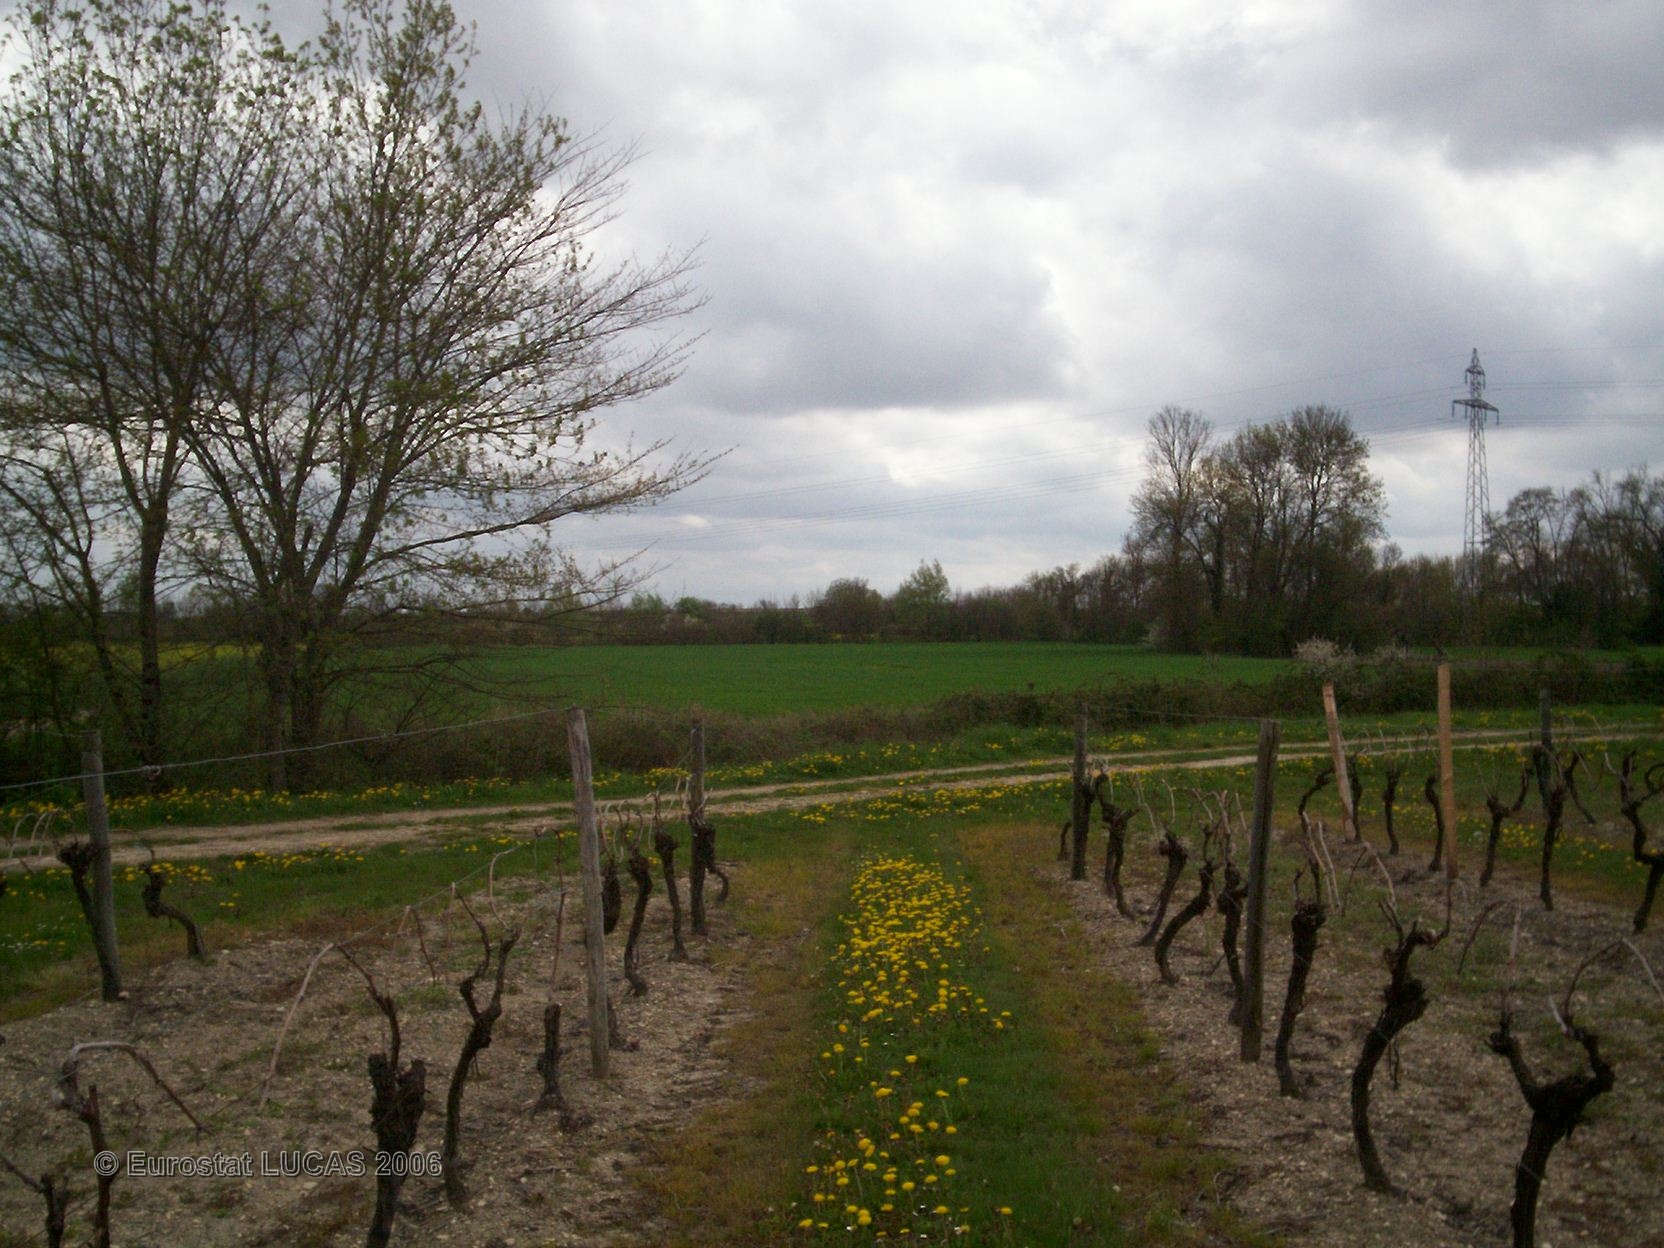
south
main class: Cropland
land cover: Vineyards
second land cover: Grassland with sparse tree/shrub cover
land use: Agriculture (excluding fallow land and kitchen gardens)
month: April
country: FR
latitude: 45.7011
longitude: -0.1787
